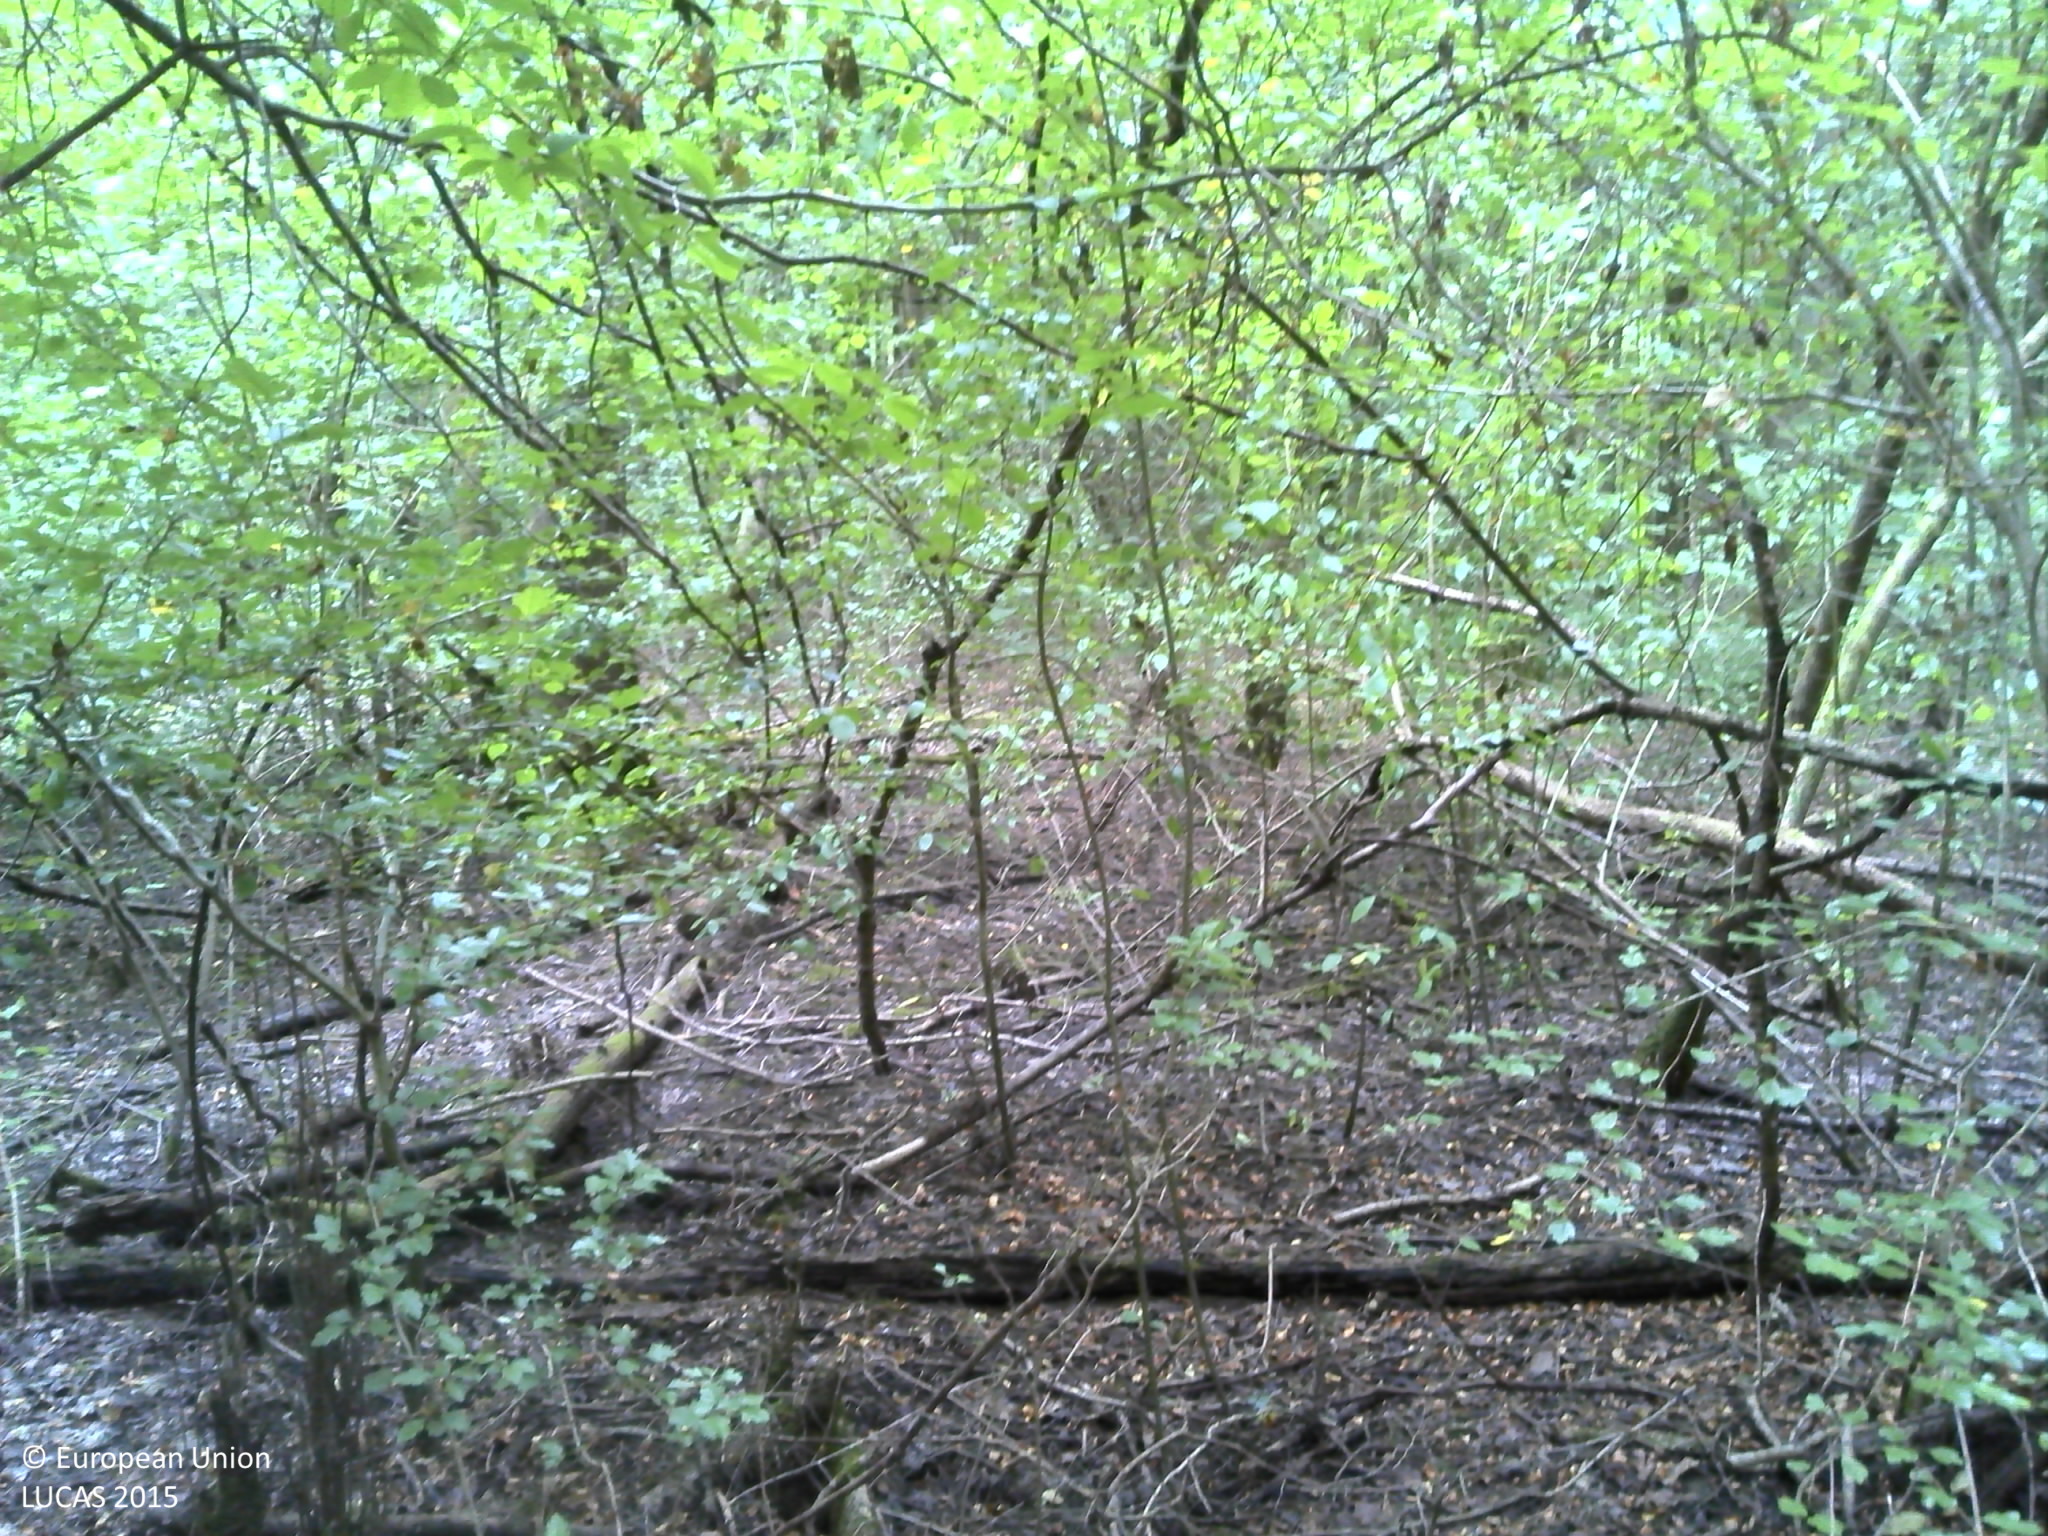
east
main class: Woodland
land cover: Broadleaved woodland
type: mesophytic deciduous forest
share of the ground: > 75 %
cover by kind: broadleaved forest trees 100 %
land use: Forestry
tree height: > 5 m
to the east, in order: Broadleaved woodland; Tracks; Broadleaved woodland
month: July
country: HR
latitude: 44.9359
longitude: 18.8125
